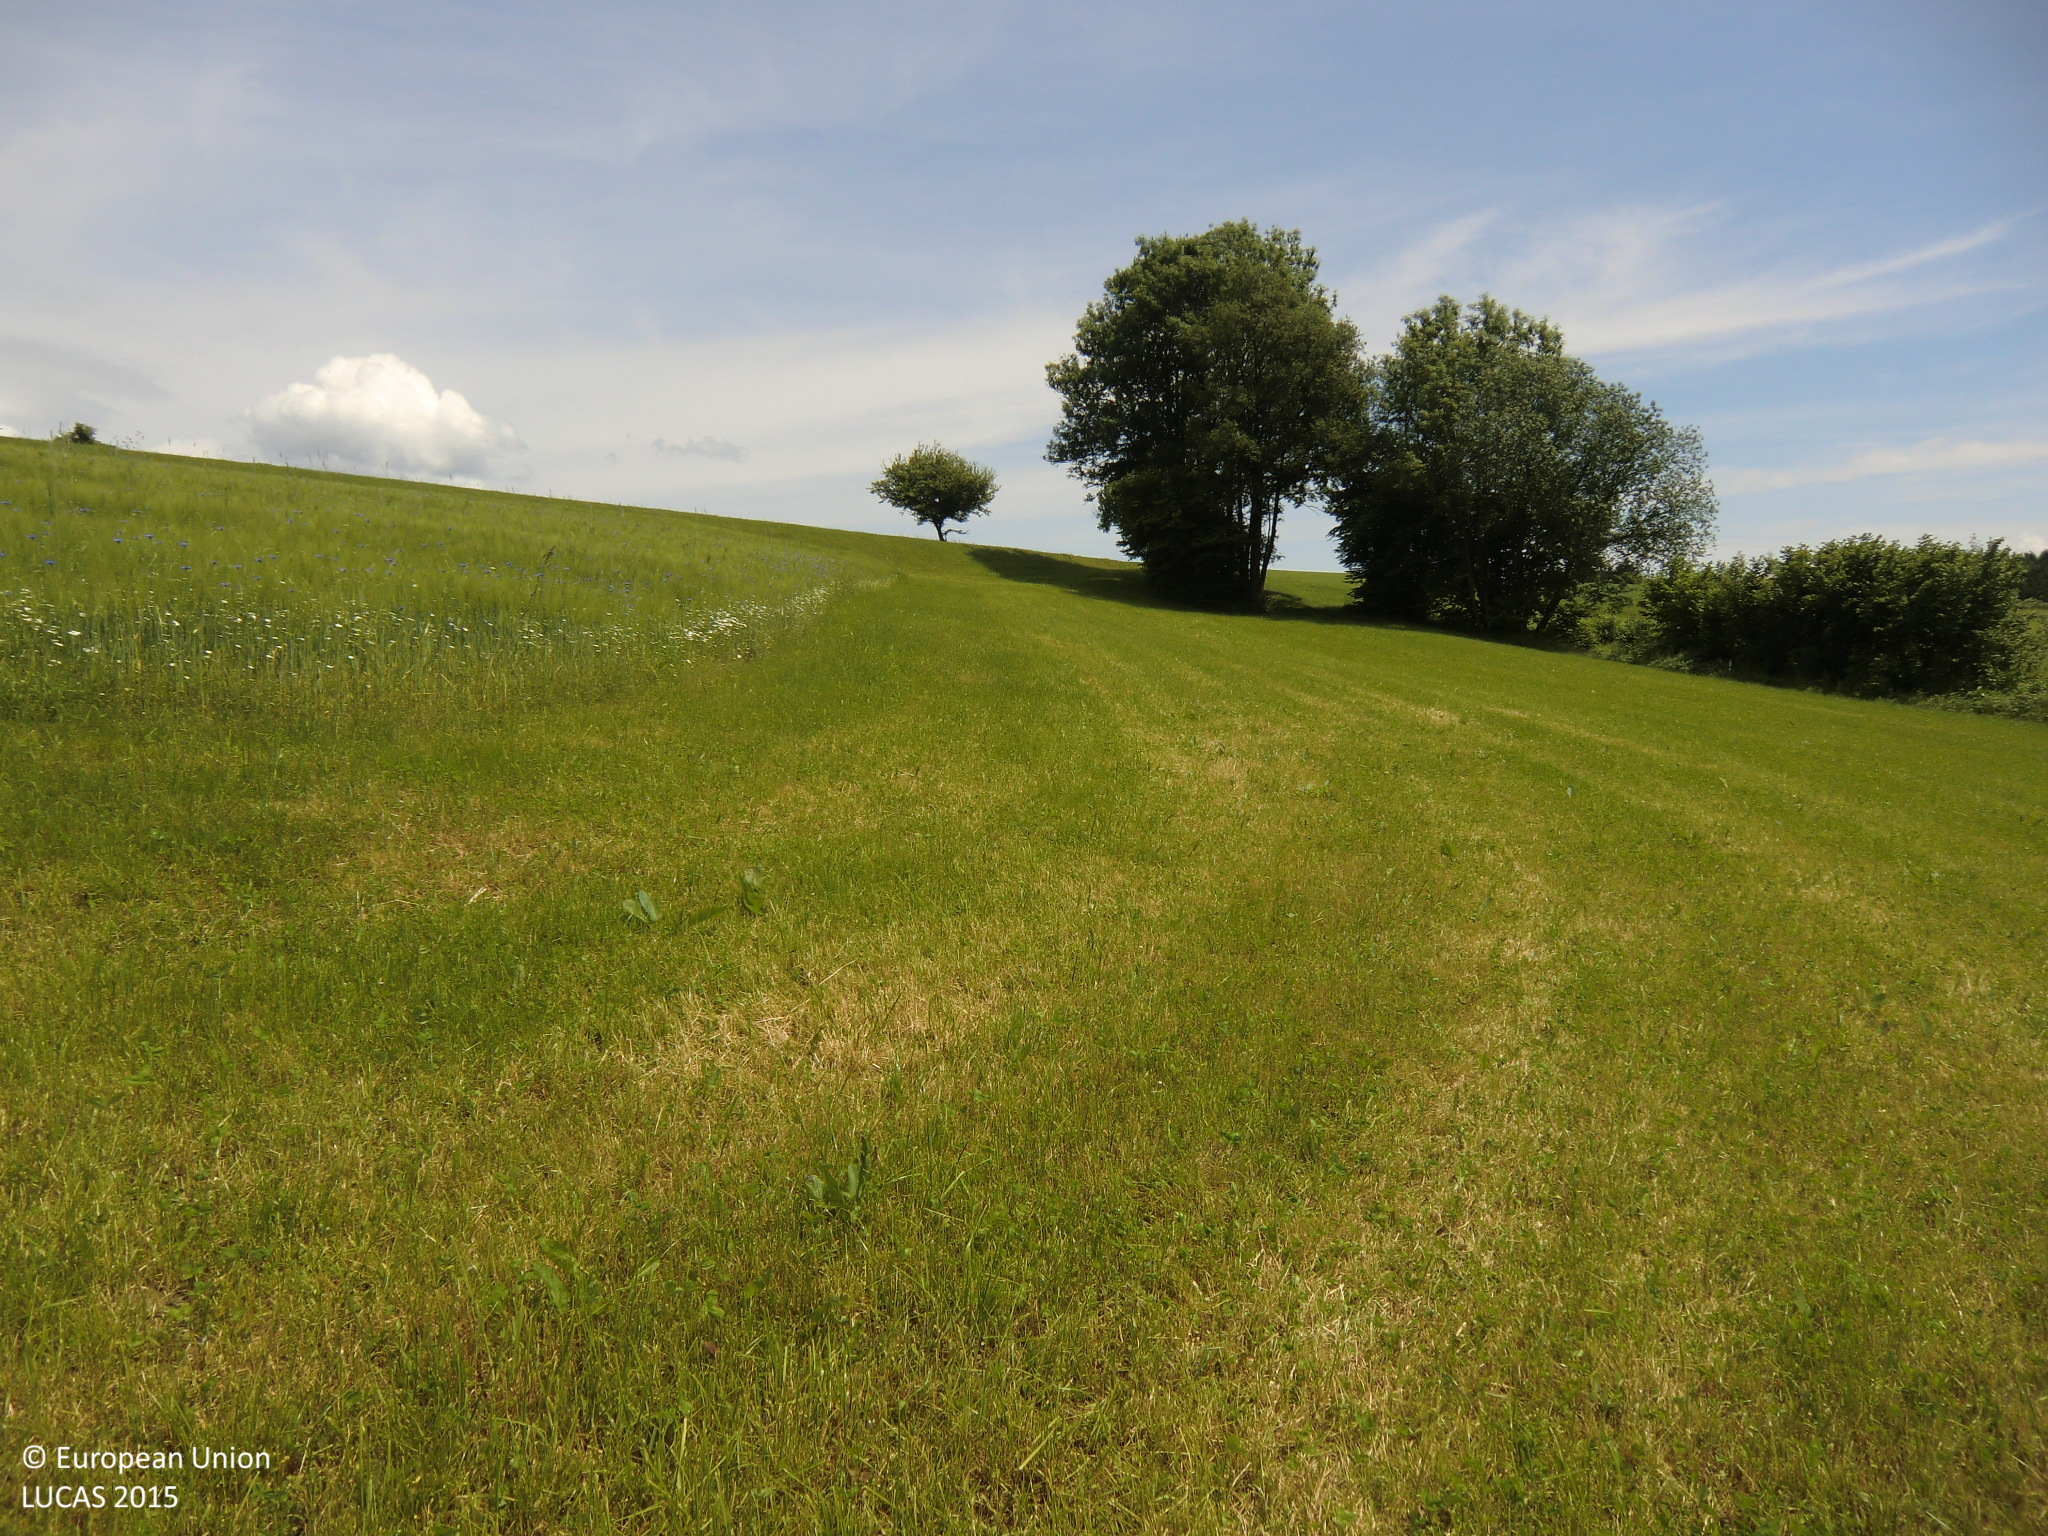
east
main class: Grassland
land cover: Grassland without tree/shrub cover
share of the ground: > 75 %
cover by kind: herbaceous plants 100 %
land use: Agriculture (excluding fallow land and kitchen gardens)
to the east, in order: Grassland without tree/shrub cover; Tracks; Grass margins; Rye; Grassland without tree/shrub cover; Single bushes/trees; Grassland without tree/shrub cover; Common wheat
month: May
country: AT
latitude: 48.2377
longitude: 14.9695
